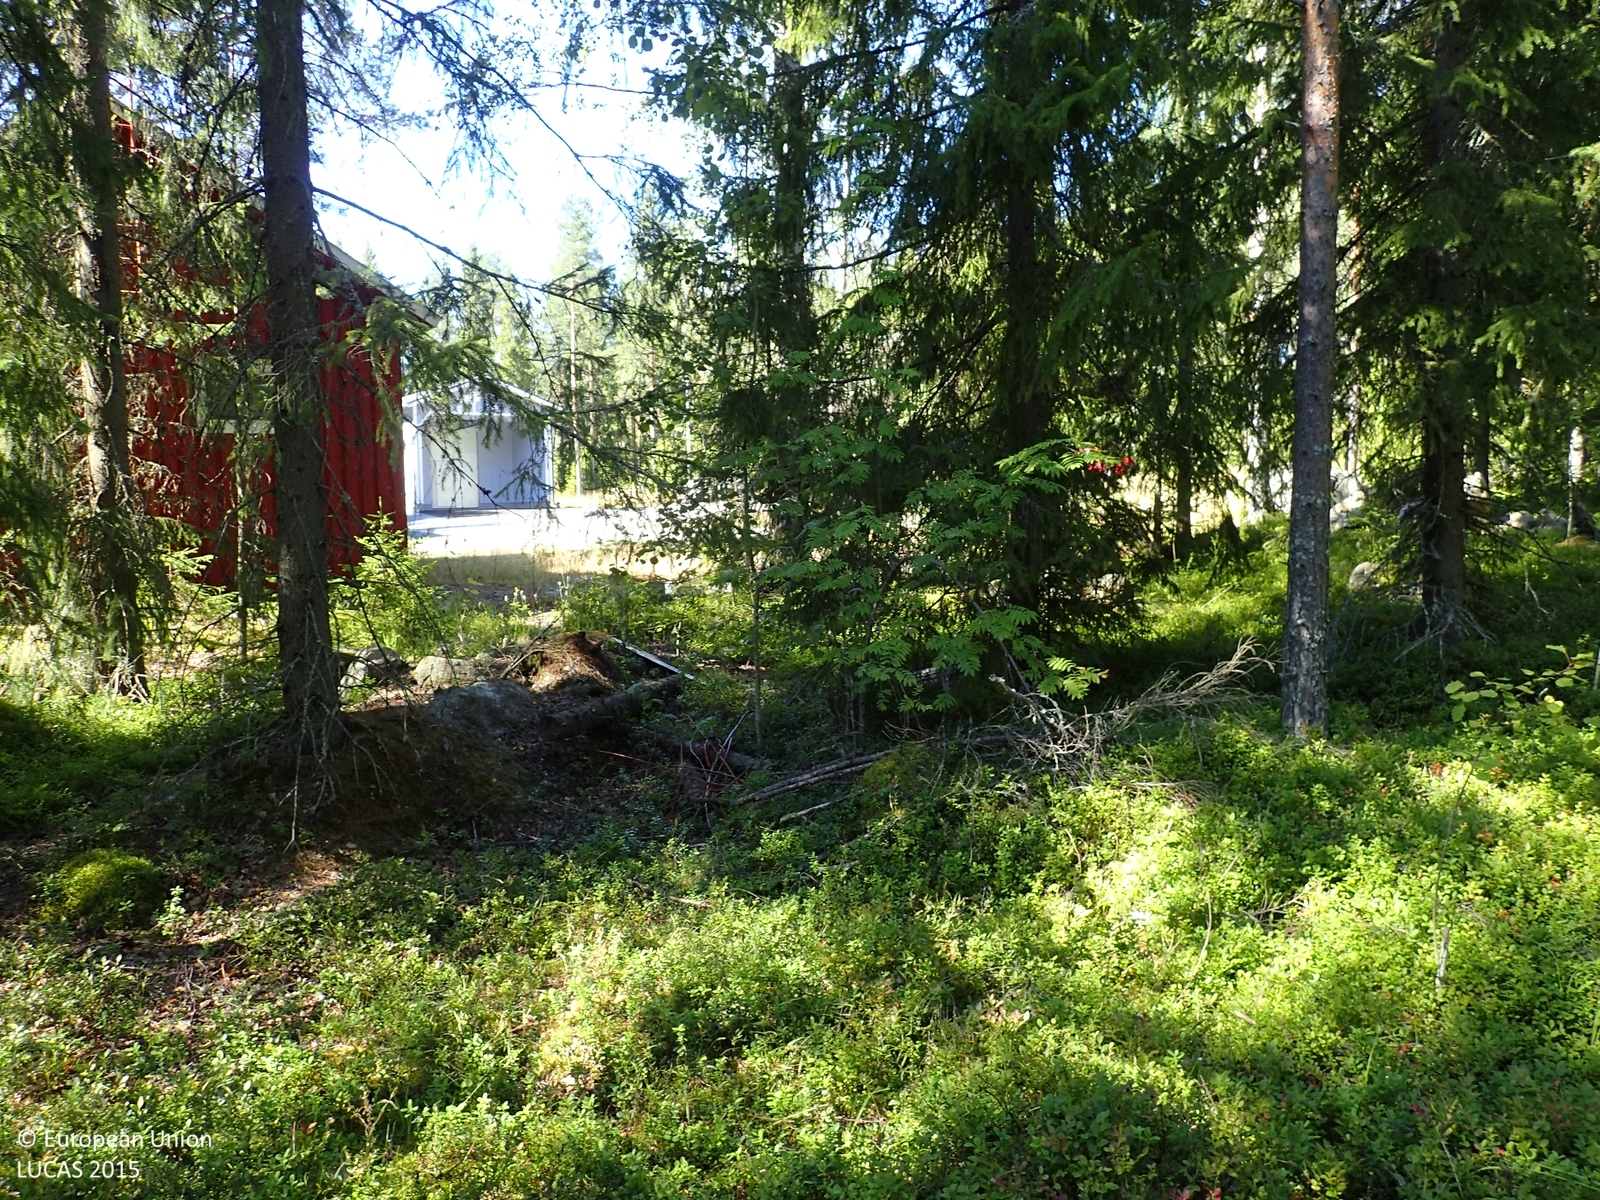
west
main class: Woodland
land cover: Other mixed woodland
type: boreal forest
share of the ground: > 75 %
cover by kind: coniferous forest trees 55 %, shrubs 25 %, broadleaved forest trees 20 %
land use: Forestry
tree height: > 5 m
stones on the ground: < 10 %
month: August
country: FI
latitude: 62.5001
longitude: 22.6173
